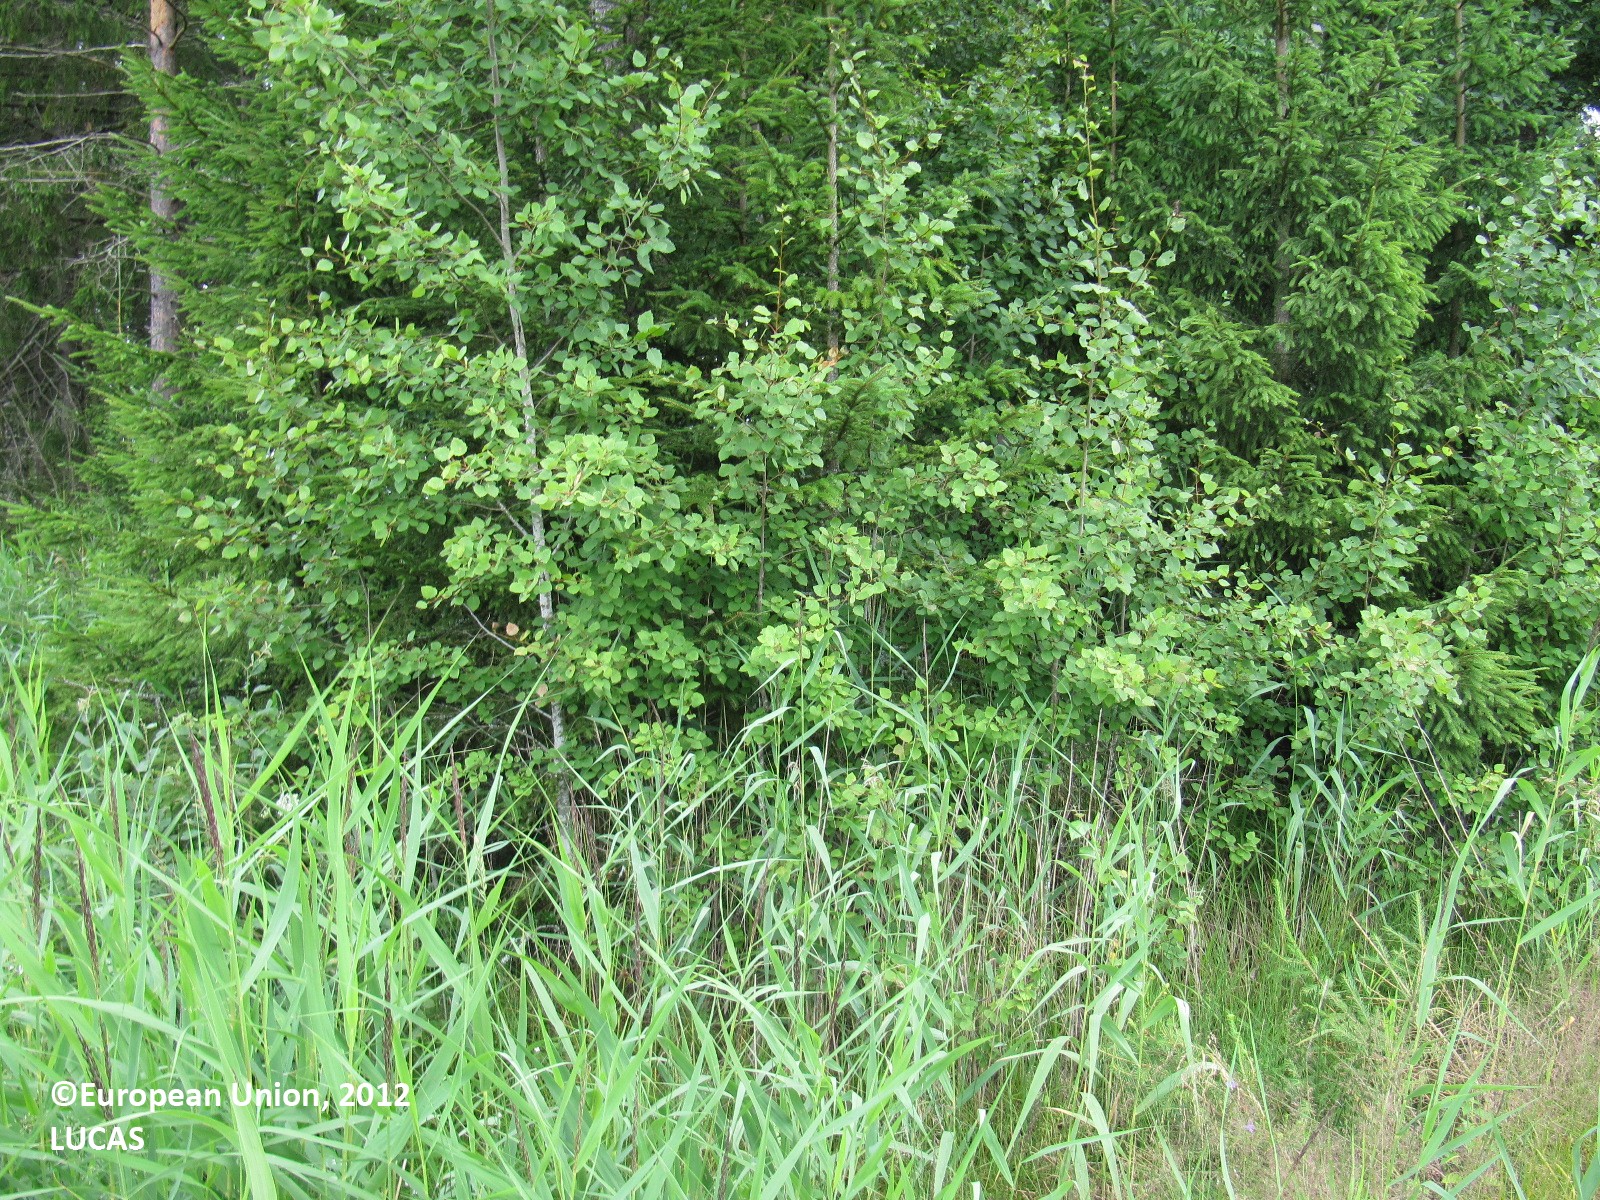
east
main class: Cropland
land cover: Other non-permanent industrial crops
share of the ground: > 75 %
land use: Agriculture (excluding fallow land and kitchen gardens)
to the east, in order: Ditches and canals; Other non-permanent industrial crops; Ditches and canals; Spruce dominated mixed woodland; Grassland with sparse tree/shrub cover; Ditches and canals; Oats
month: July
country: FI
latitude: 60.7219
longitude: 23.2609
